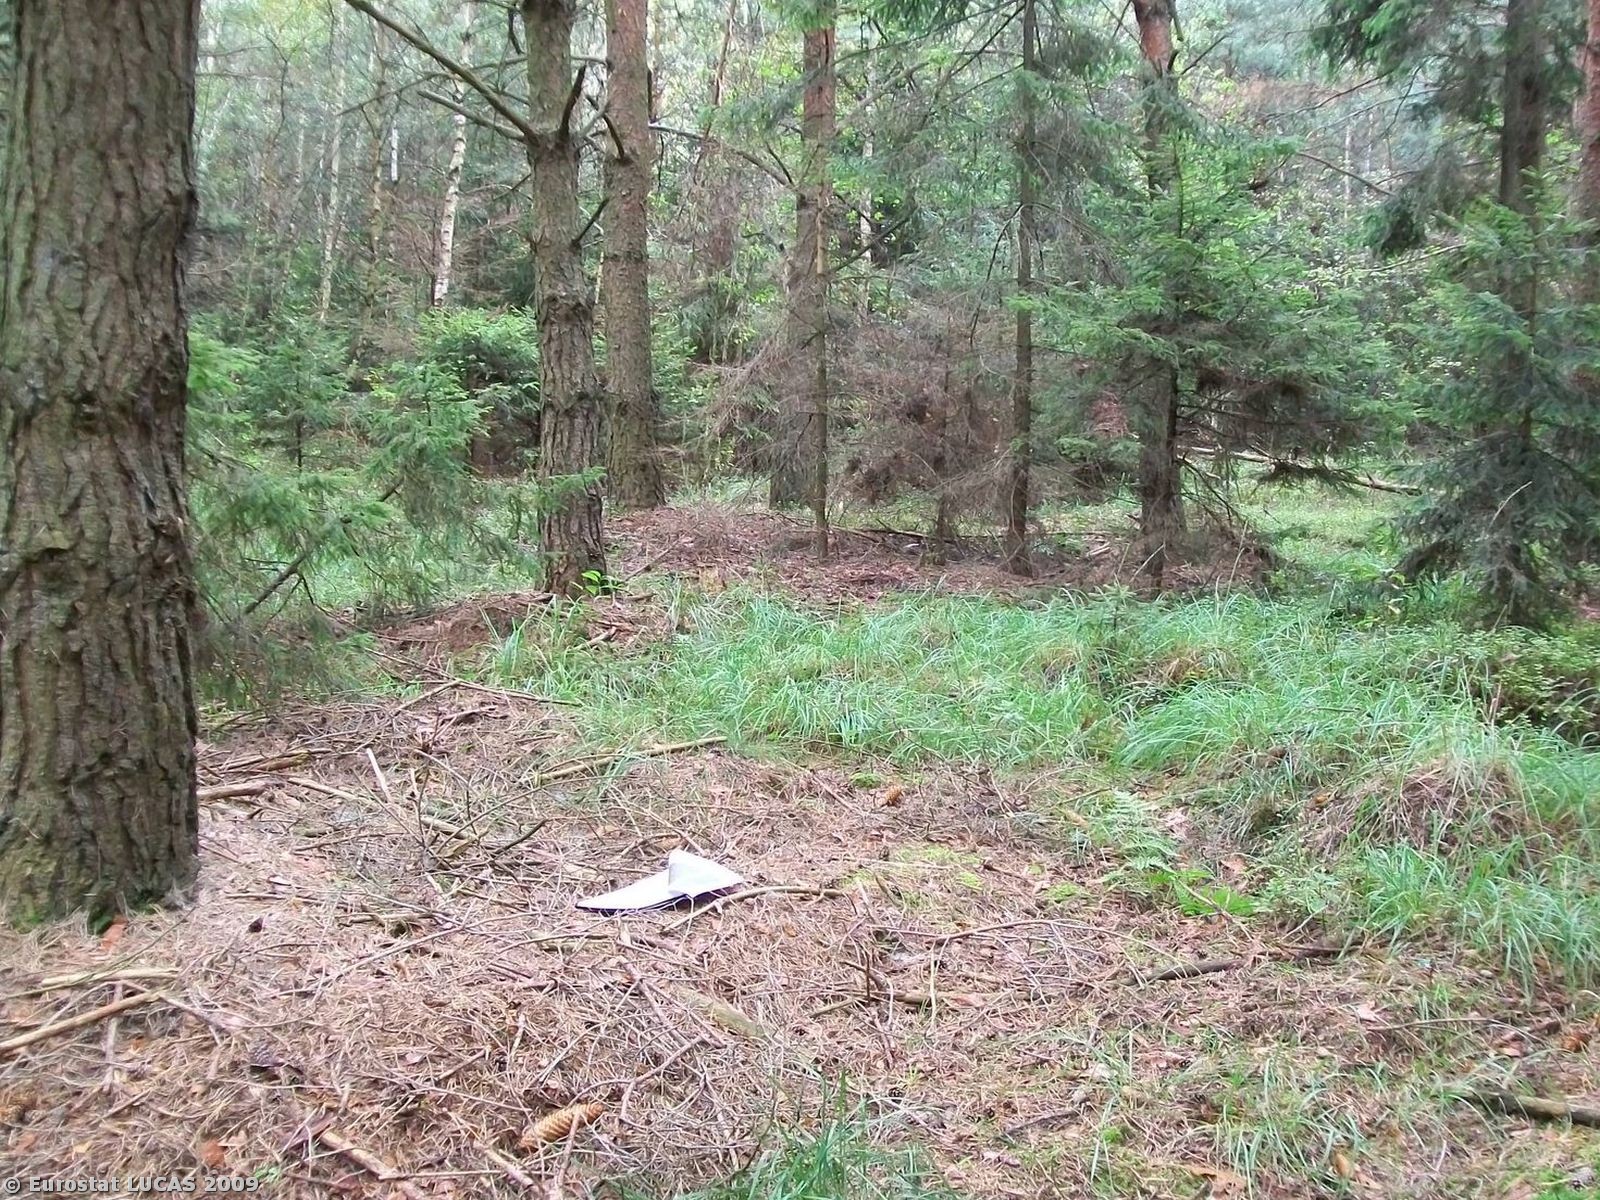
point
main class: Woodland
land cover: Broadleaved woodland
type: mesophytic deciduous forest
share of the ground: > 75 %
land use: Forestry
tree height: > 5 m
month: July
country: PL
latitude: 50.2782
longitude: 22.1419
